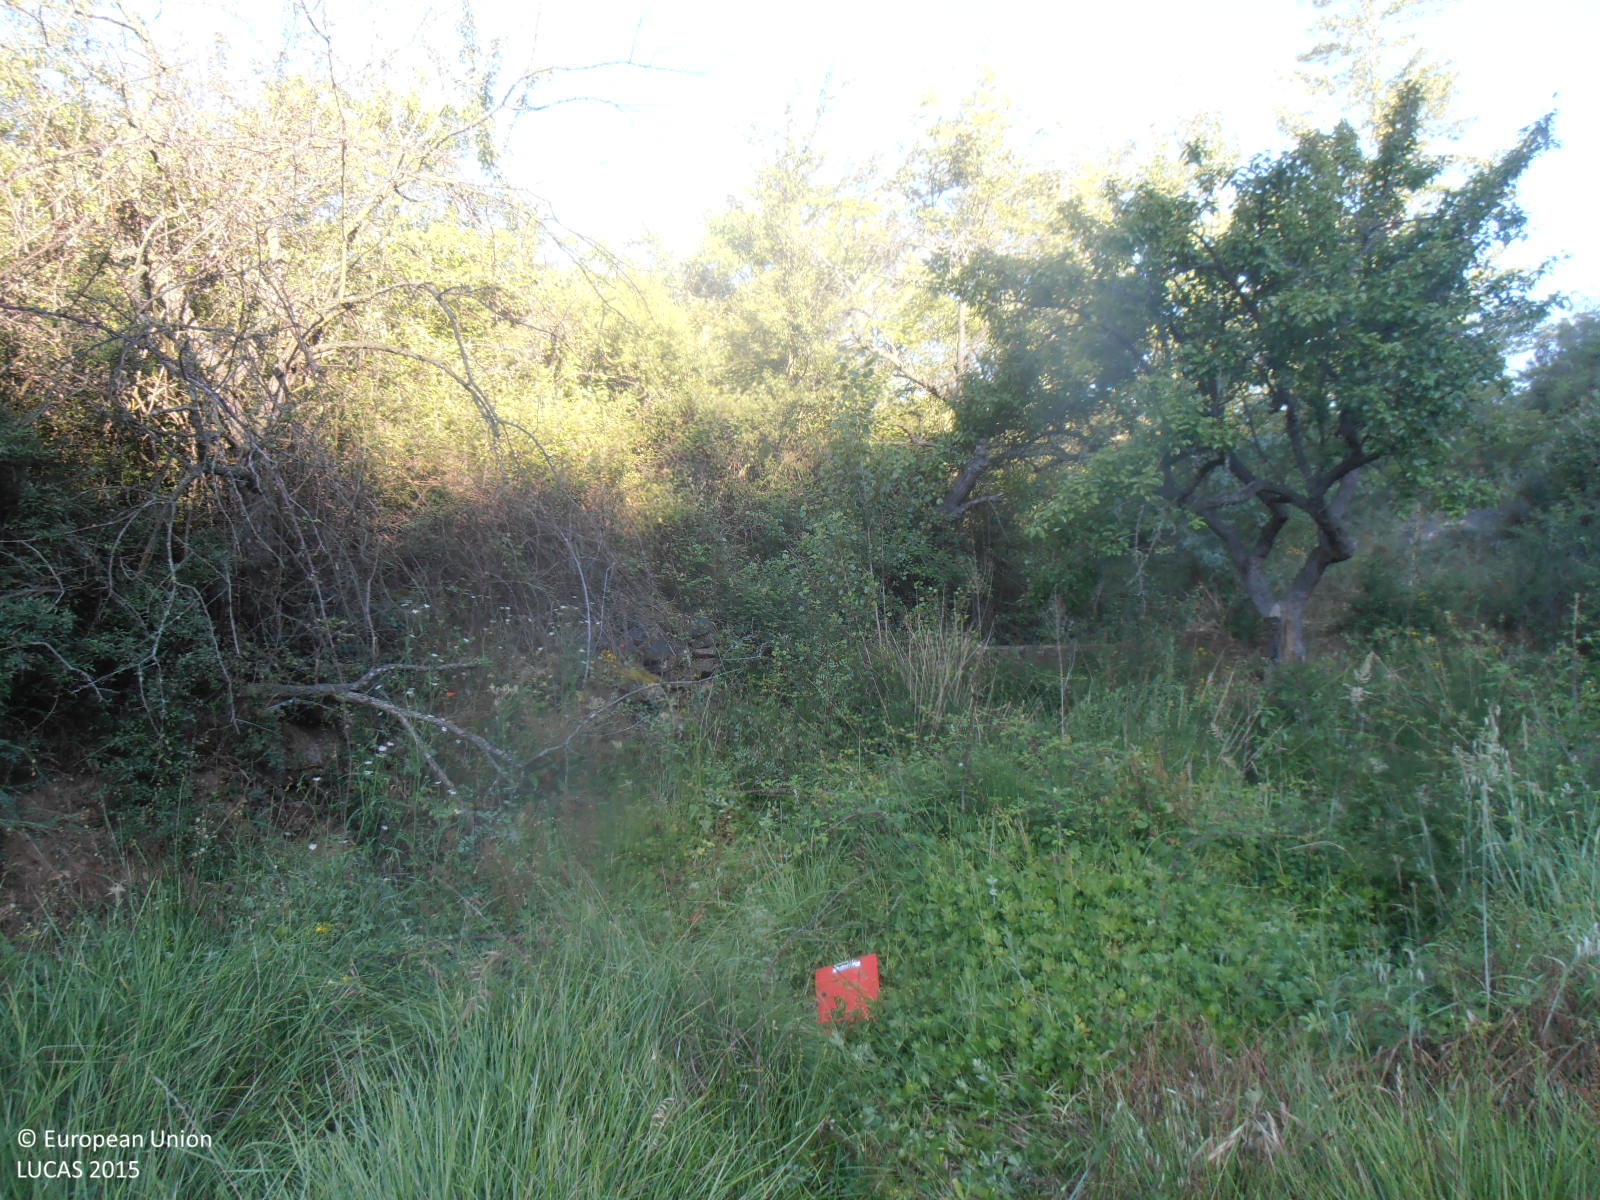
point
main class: Shrubland
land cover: Shrubland with sparse tree cover
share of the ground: > 75 %
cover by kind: shrubs 95 %, broadleaved forest trees 5 %
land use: Semi-natural and natural areas not in use
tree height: > 5 m
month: June
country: ES
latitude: 41.4067
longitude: -1.3998
